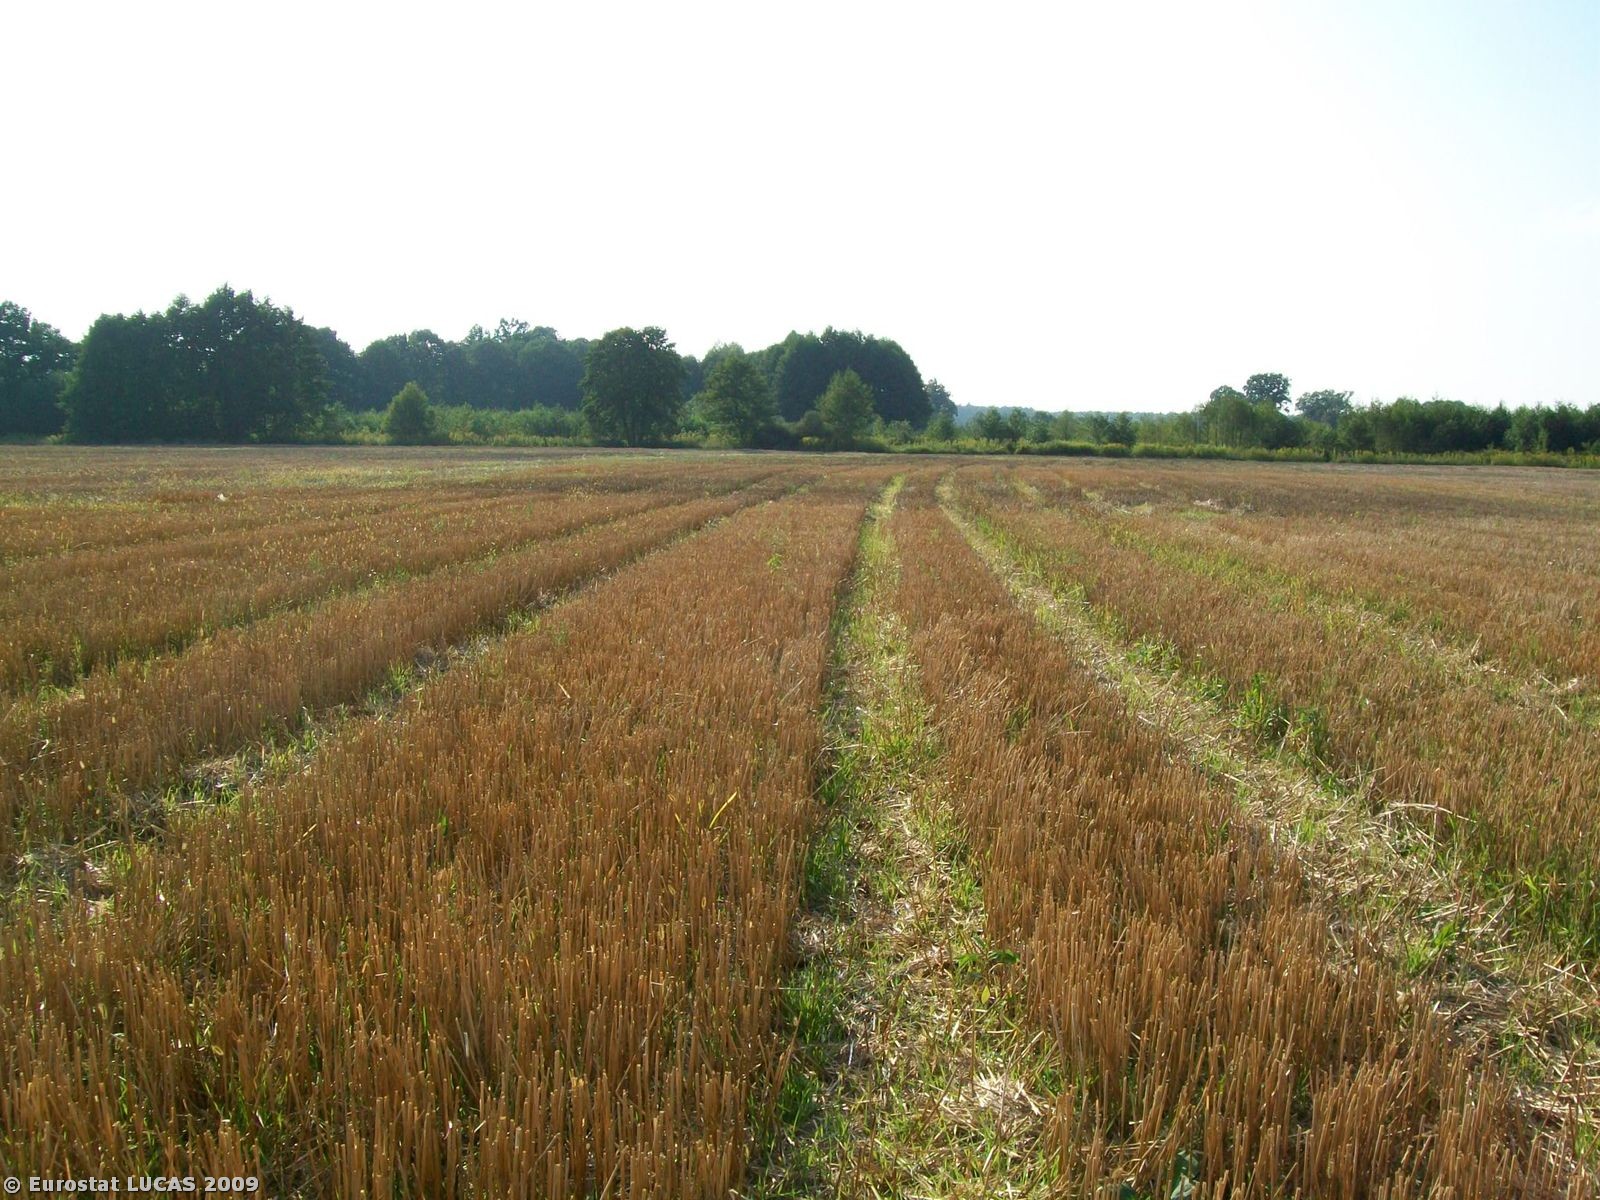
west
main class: Cropland
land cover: Rye
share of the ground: < 10 %
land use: Agriculture (excluding fallow land and kitchen gardens)
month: August
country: PL
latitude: 51.0122
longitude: 17.8974
